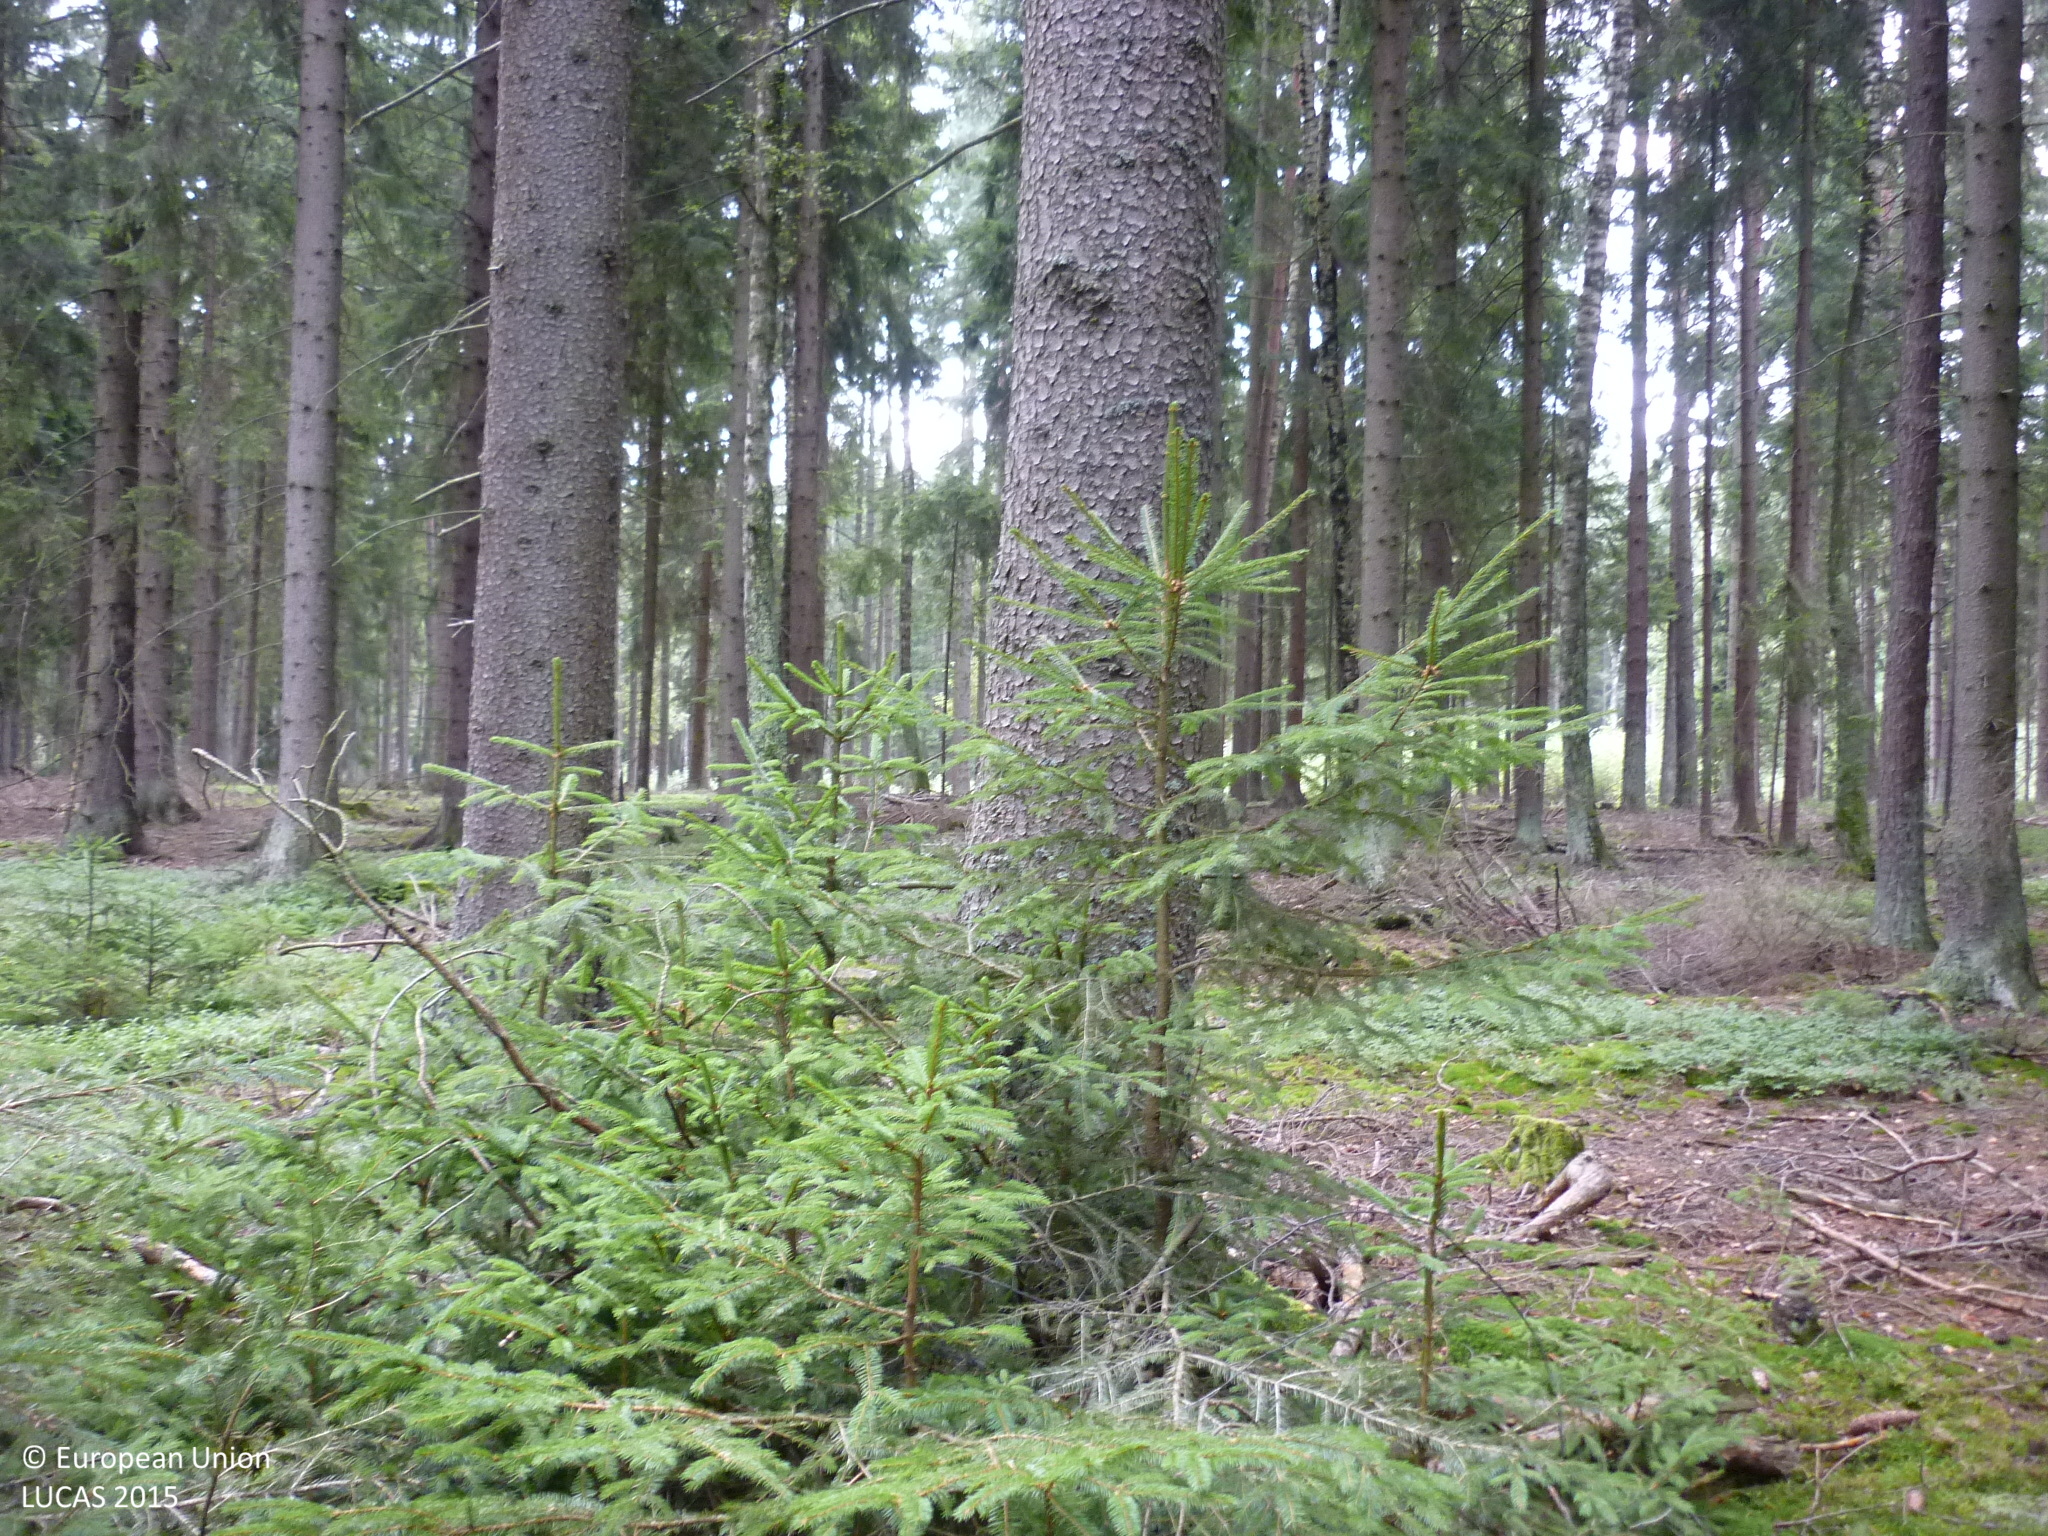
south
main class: Woodland
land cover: Spruce dominated coniferous woodland
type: hemiboreal forest and nemoral coniferous forest and mixed broadleaved-coniferous forest
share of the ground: > 75 %
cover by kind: coniferous forest trees 95 %, shrubs 5 %
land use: Forestry
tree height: > 5 m
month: September
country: AT
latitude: 48.9351
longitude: 15.0941
